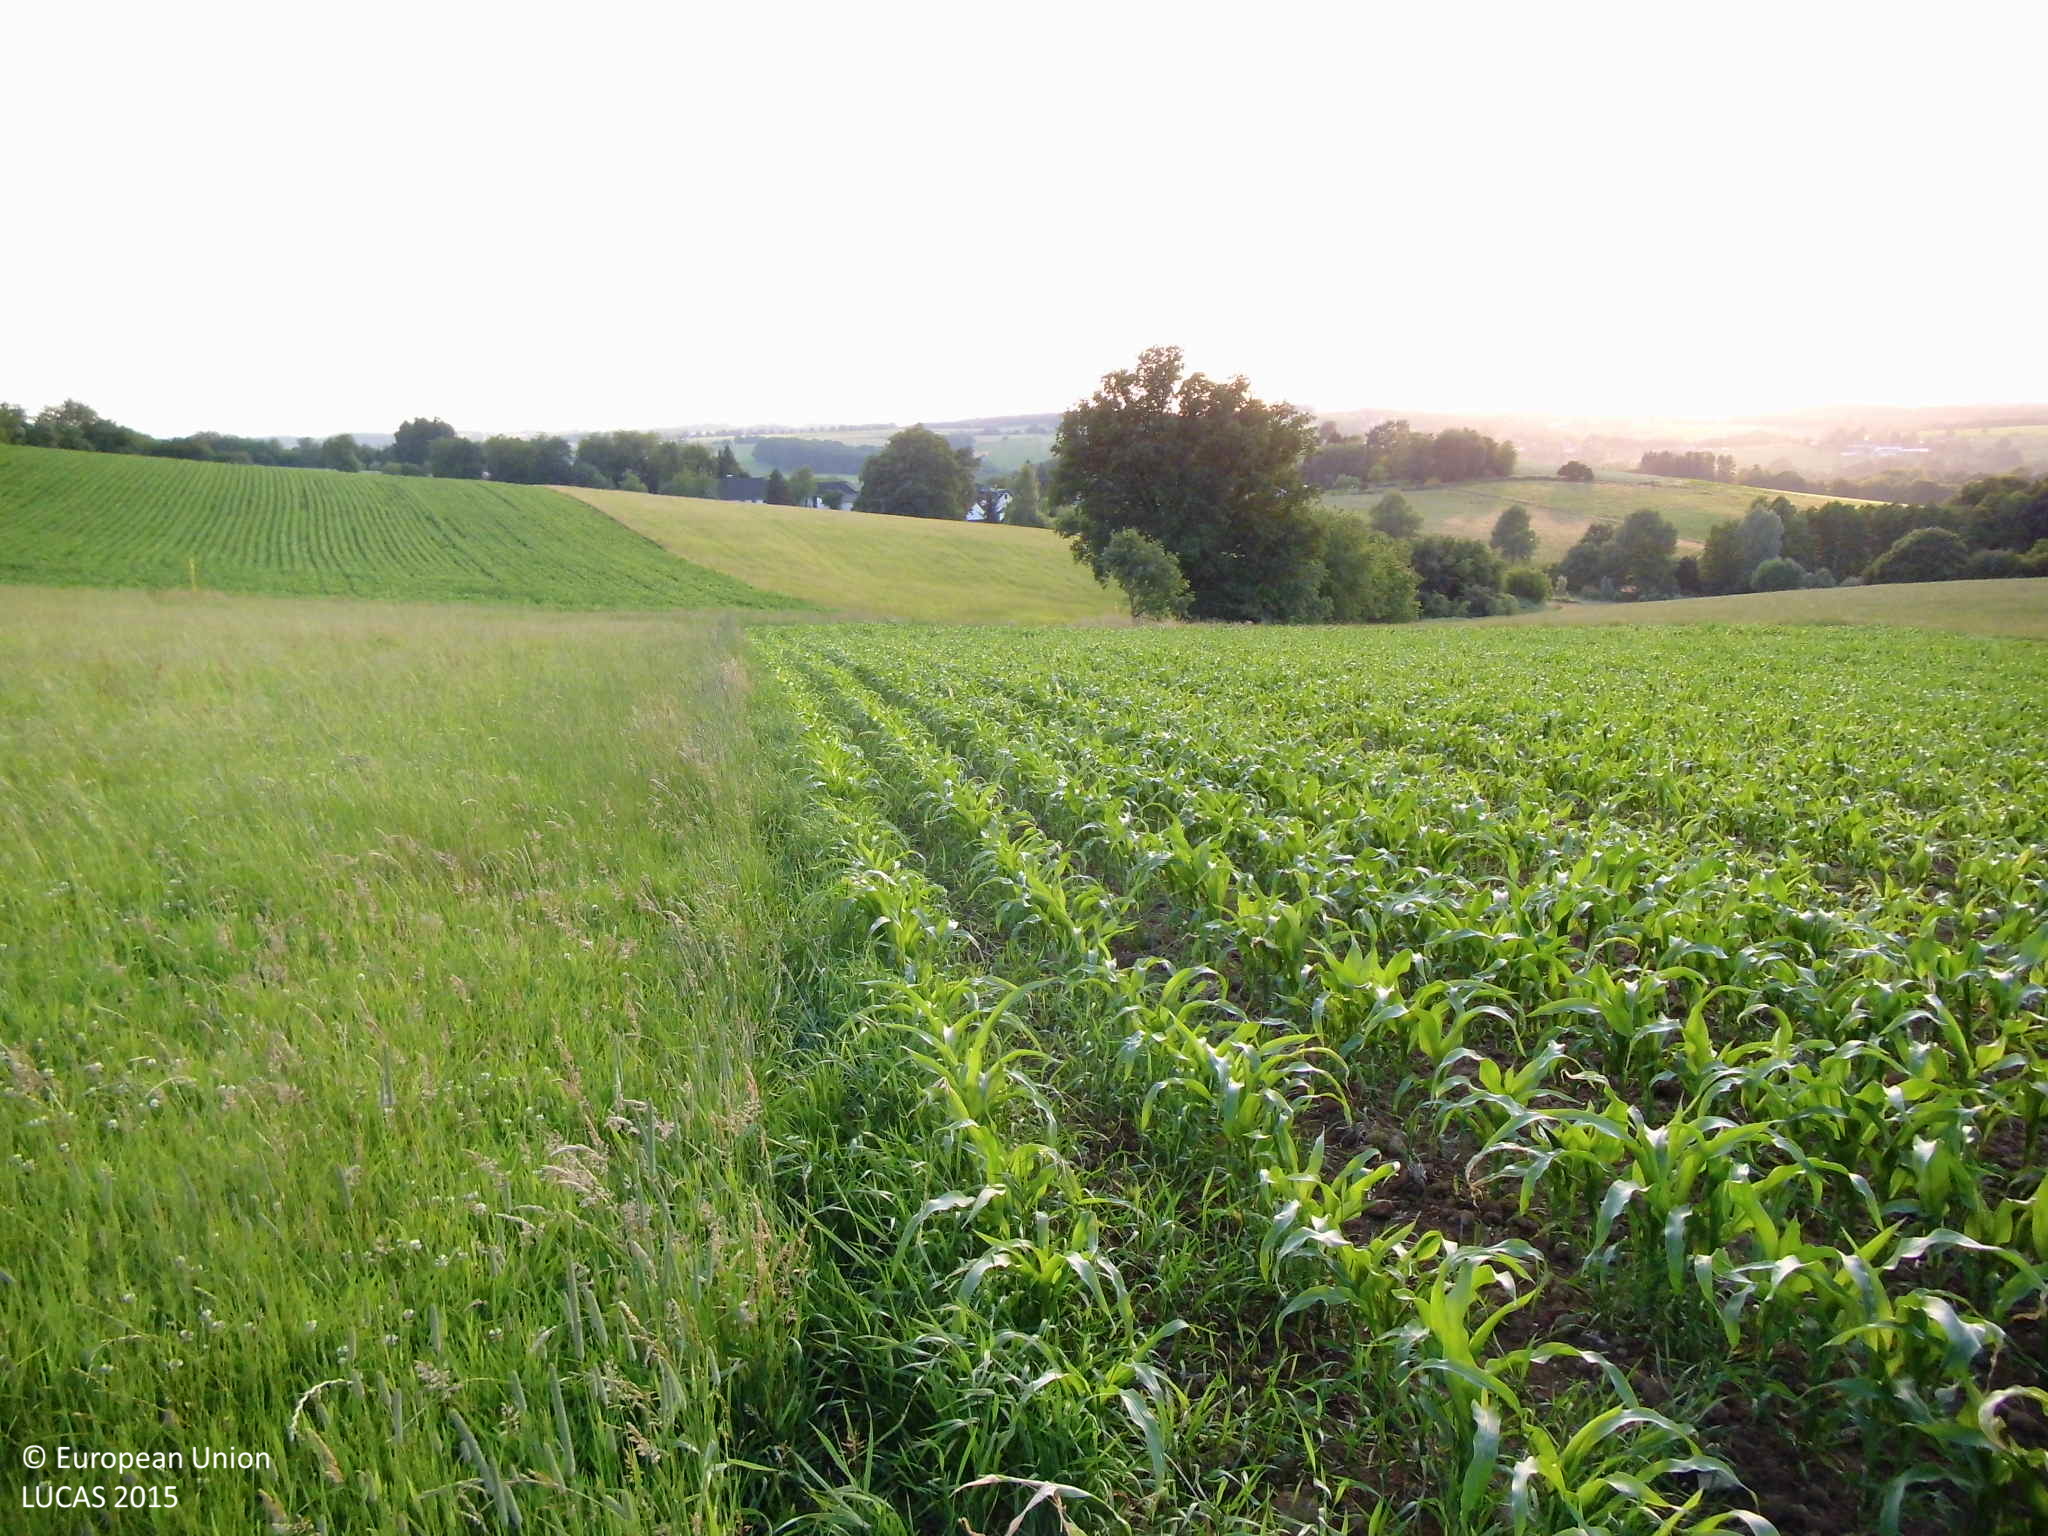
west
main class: Cropland
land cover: Maize
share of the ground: 50 - 75 %
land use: Agriculture (excluding fallow land and kitchen gardens)
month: June
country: DE
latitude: 50.8575
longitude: 7.4573
